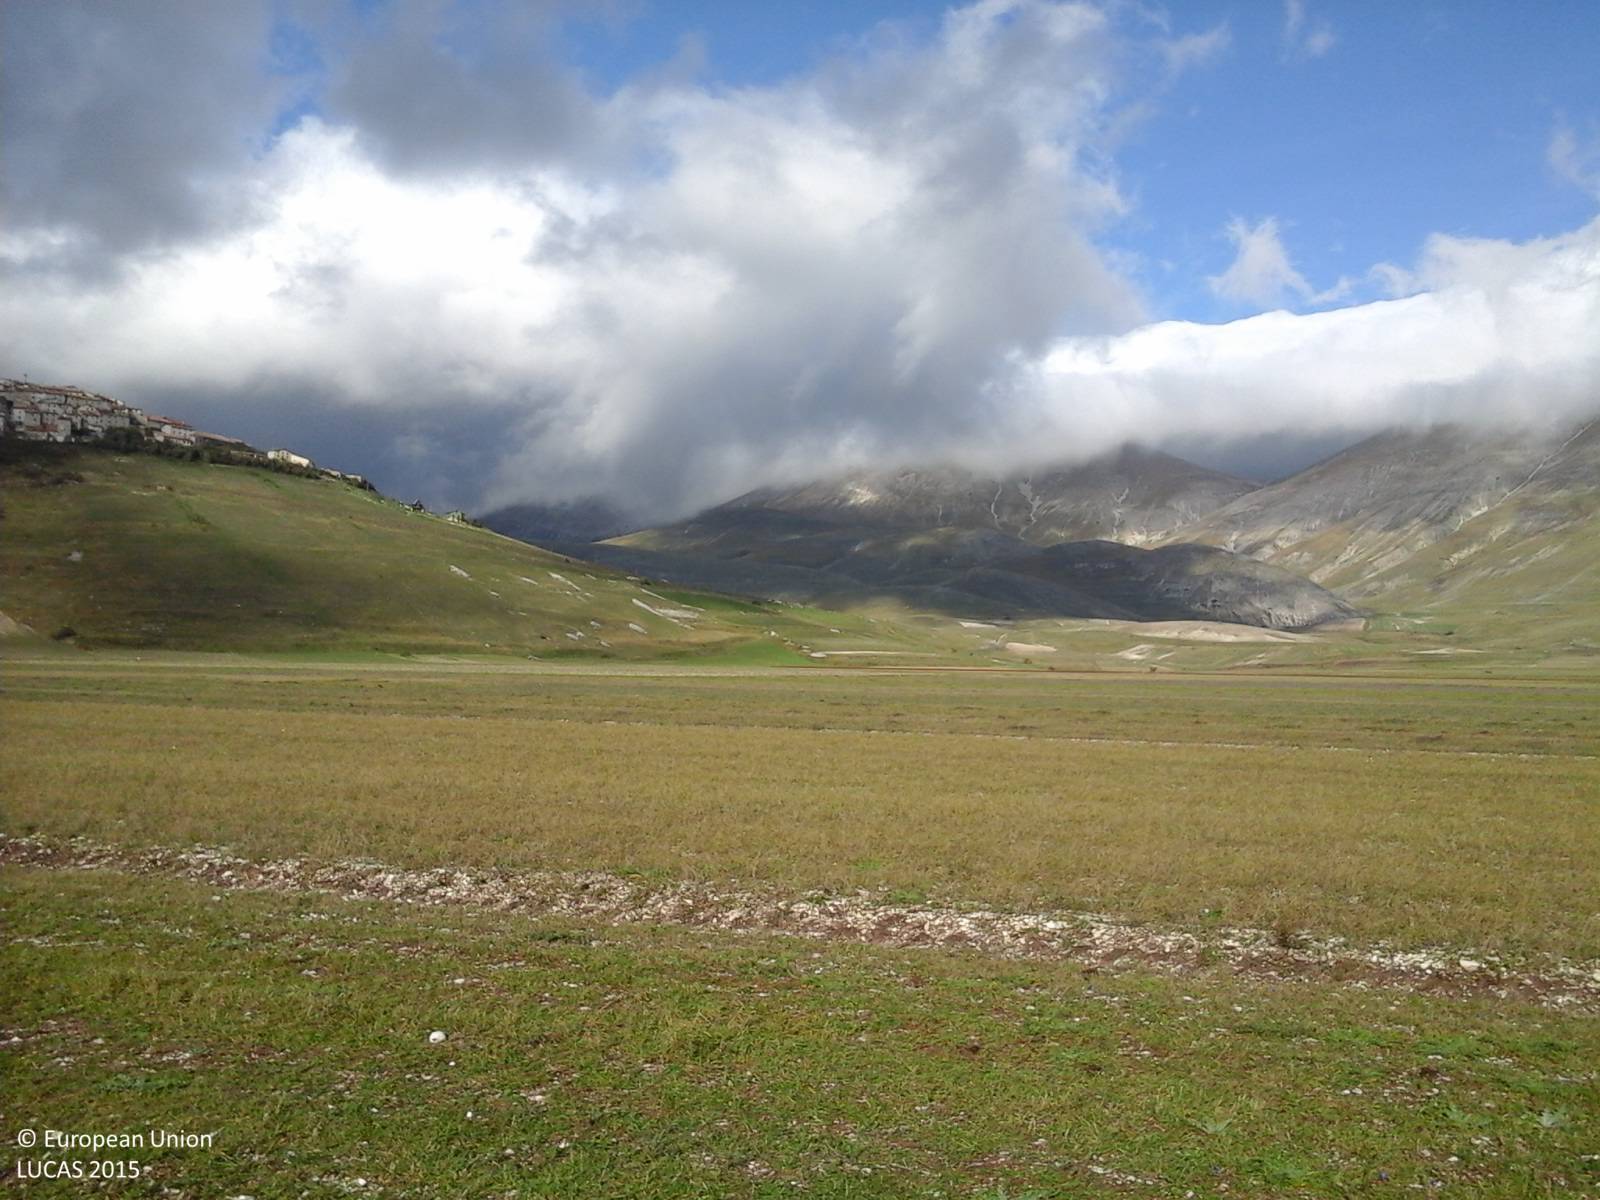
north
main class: Grassland
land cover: Grassland without tree/shrub cover
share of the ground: > 75 %
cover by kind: herbaceous plants 100 %
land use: Agriculture (excluding fallow land and kitchen gardens)
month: October
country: IT
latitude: 42.8201
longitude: 13.2074
